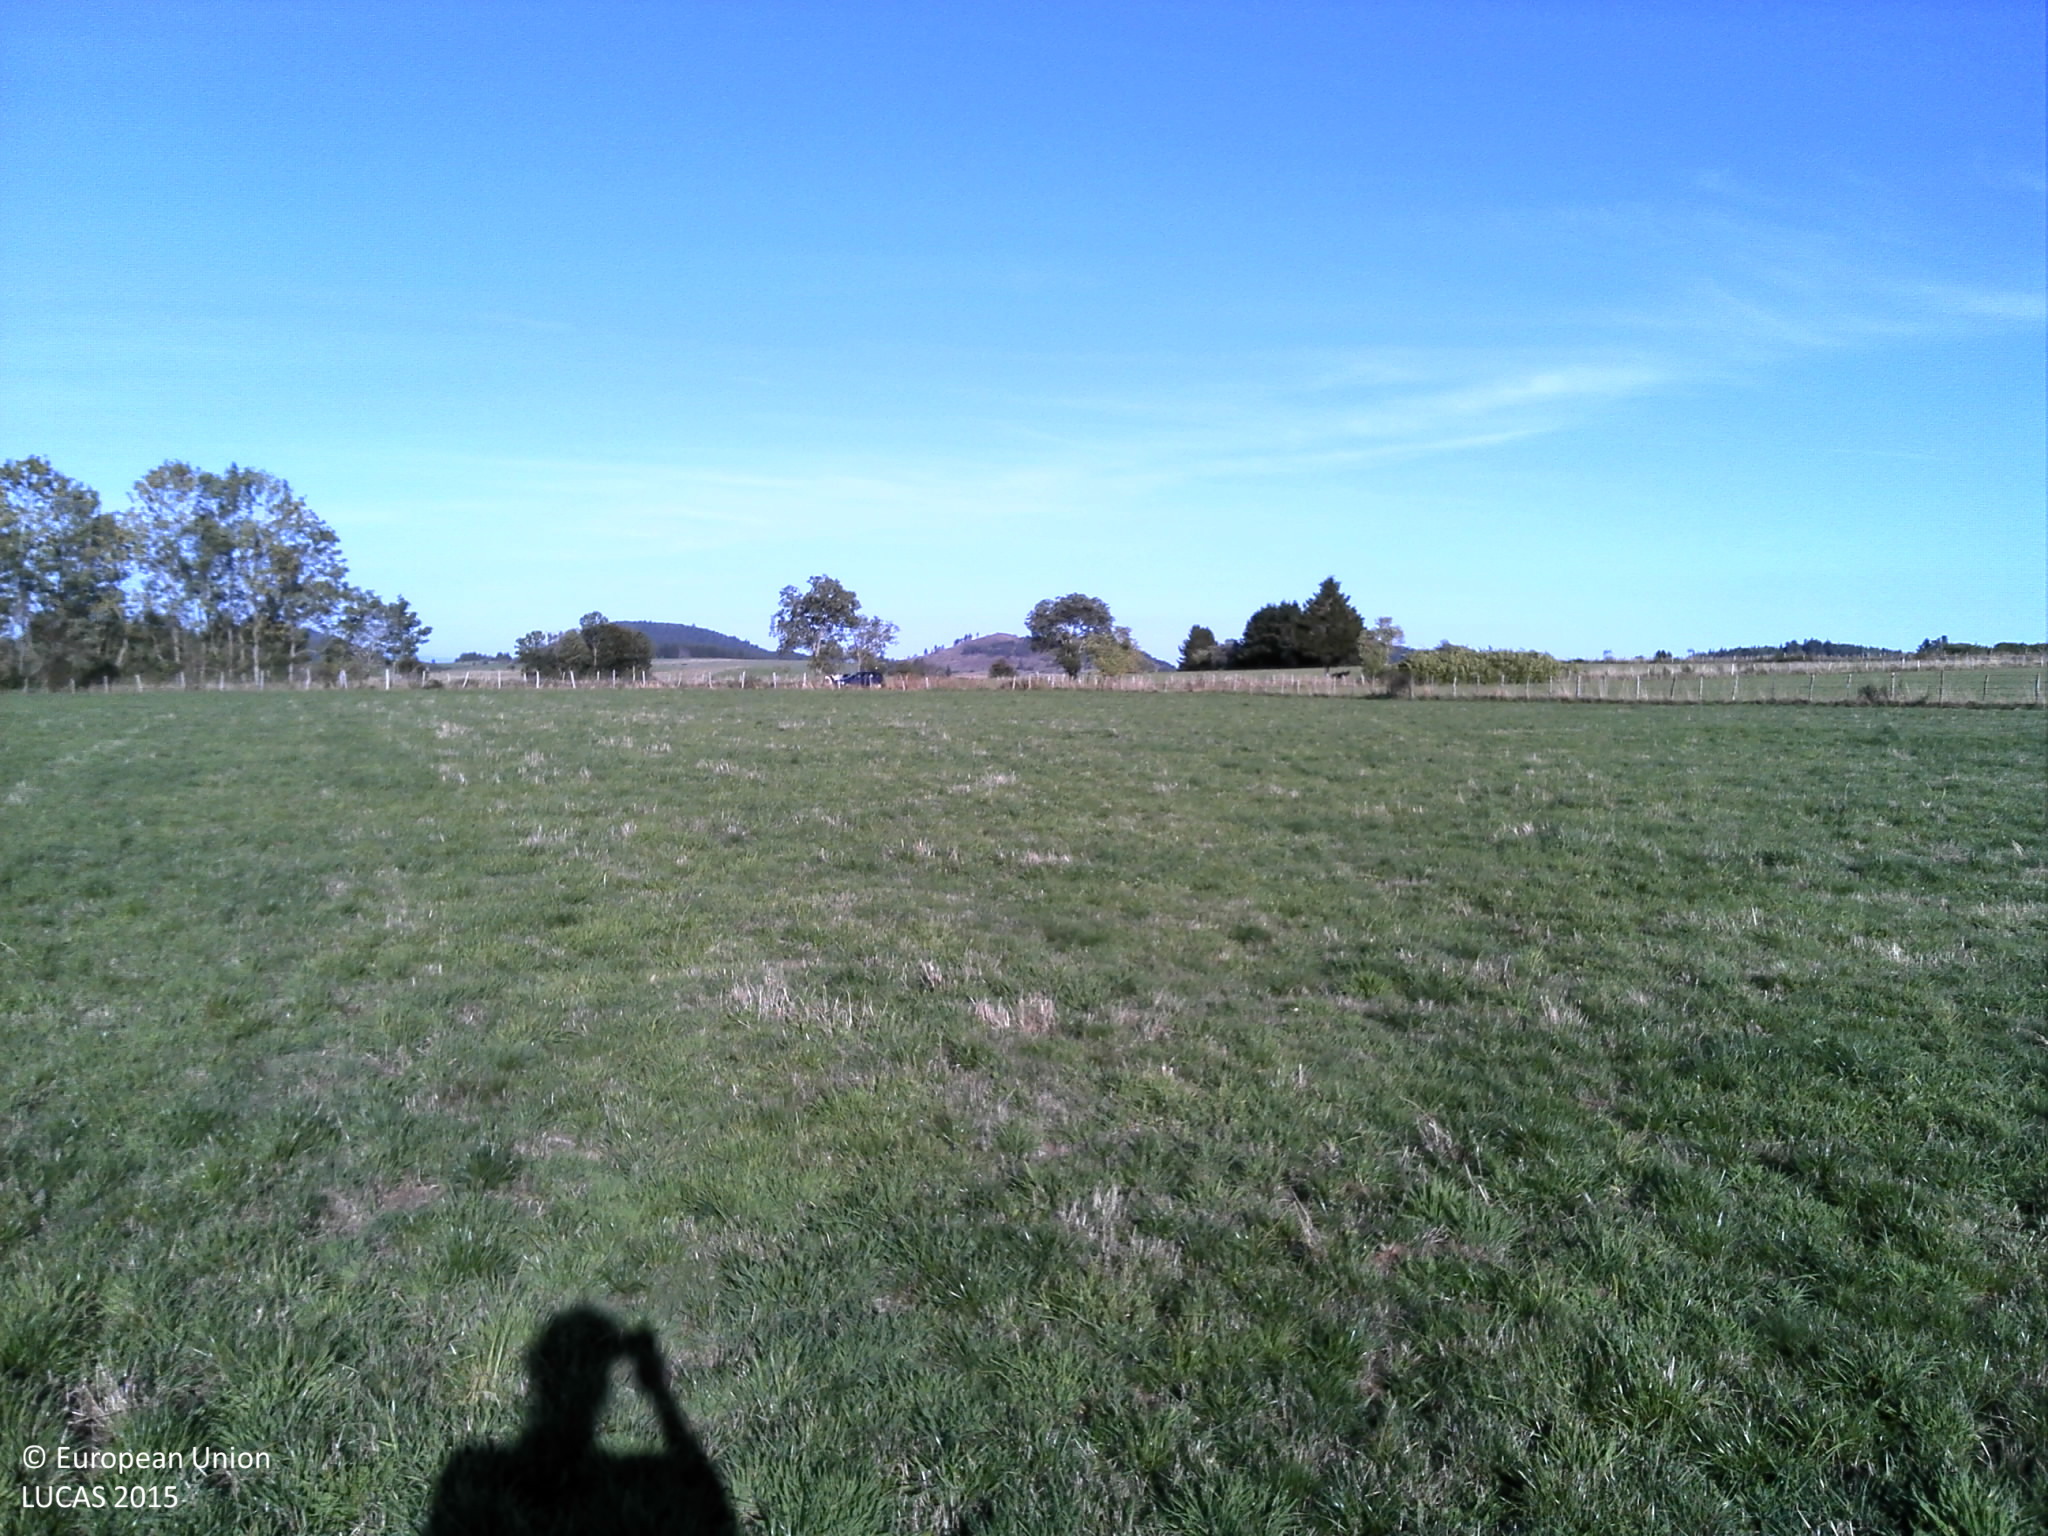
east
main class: Grassland
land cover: Grassland without tree/shrub cover
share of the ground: > 75 %
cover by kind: herbaceous plants 100 %
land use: Agriculture (excluding fallow land and kitchen gardens)
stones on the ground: < 10 %
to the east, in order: Grassland without tree/shrub cover; Fences; Grassland without tree/shrub cover; Fences; Tracks; Single bushes/trees; Fences; Grassland without tree/shrub cover
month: September
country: FR
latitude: 45.6632
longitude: 2.9018
